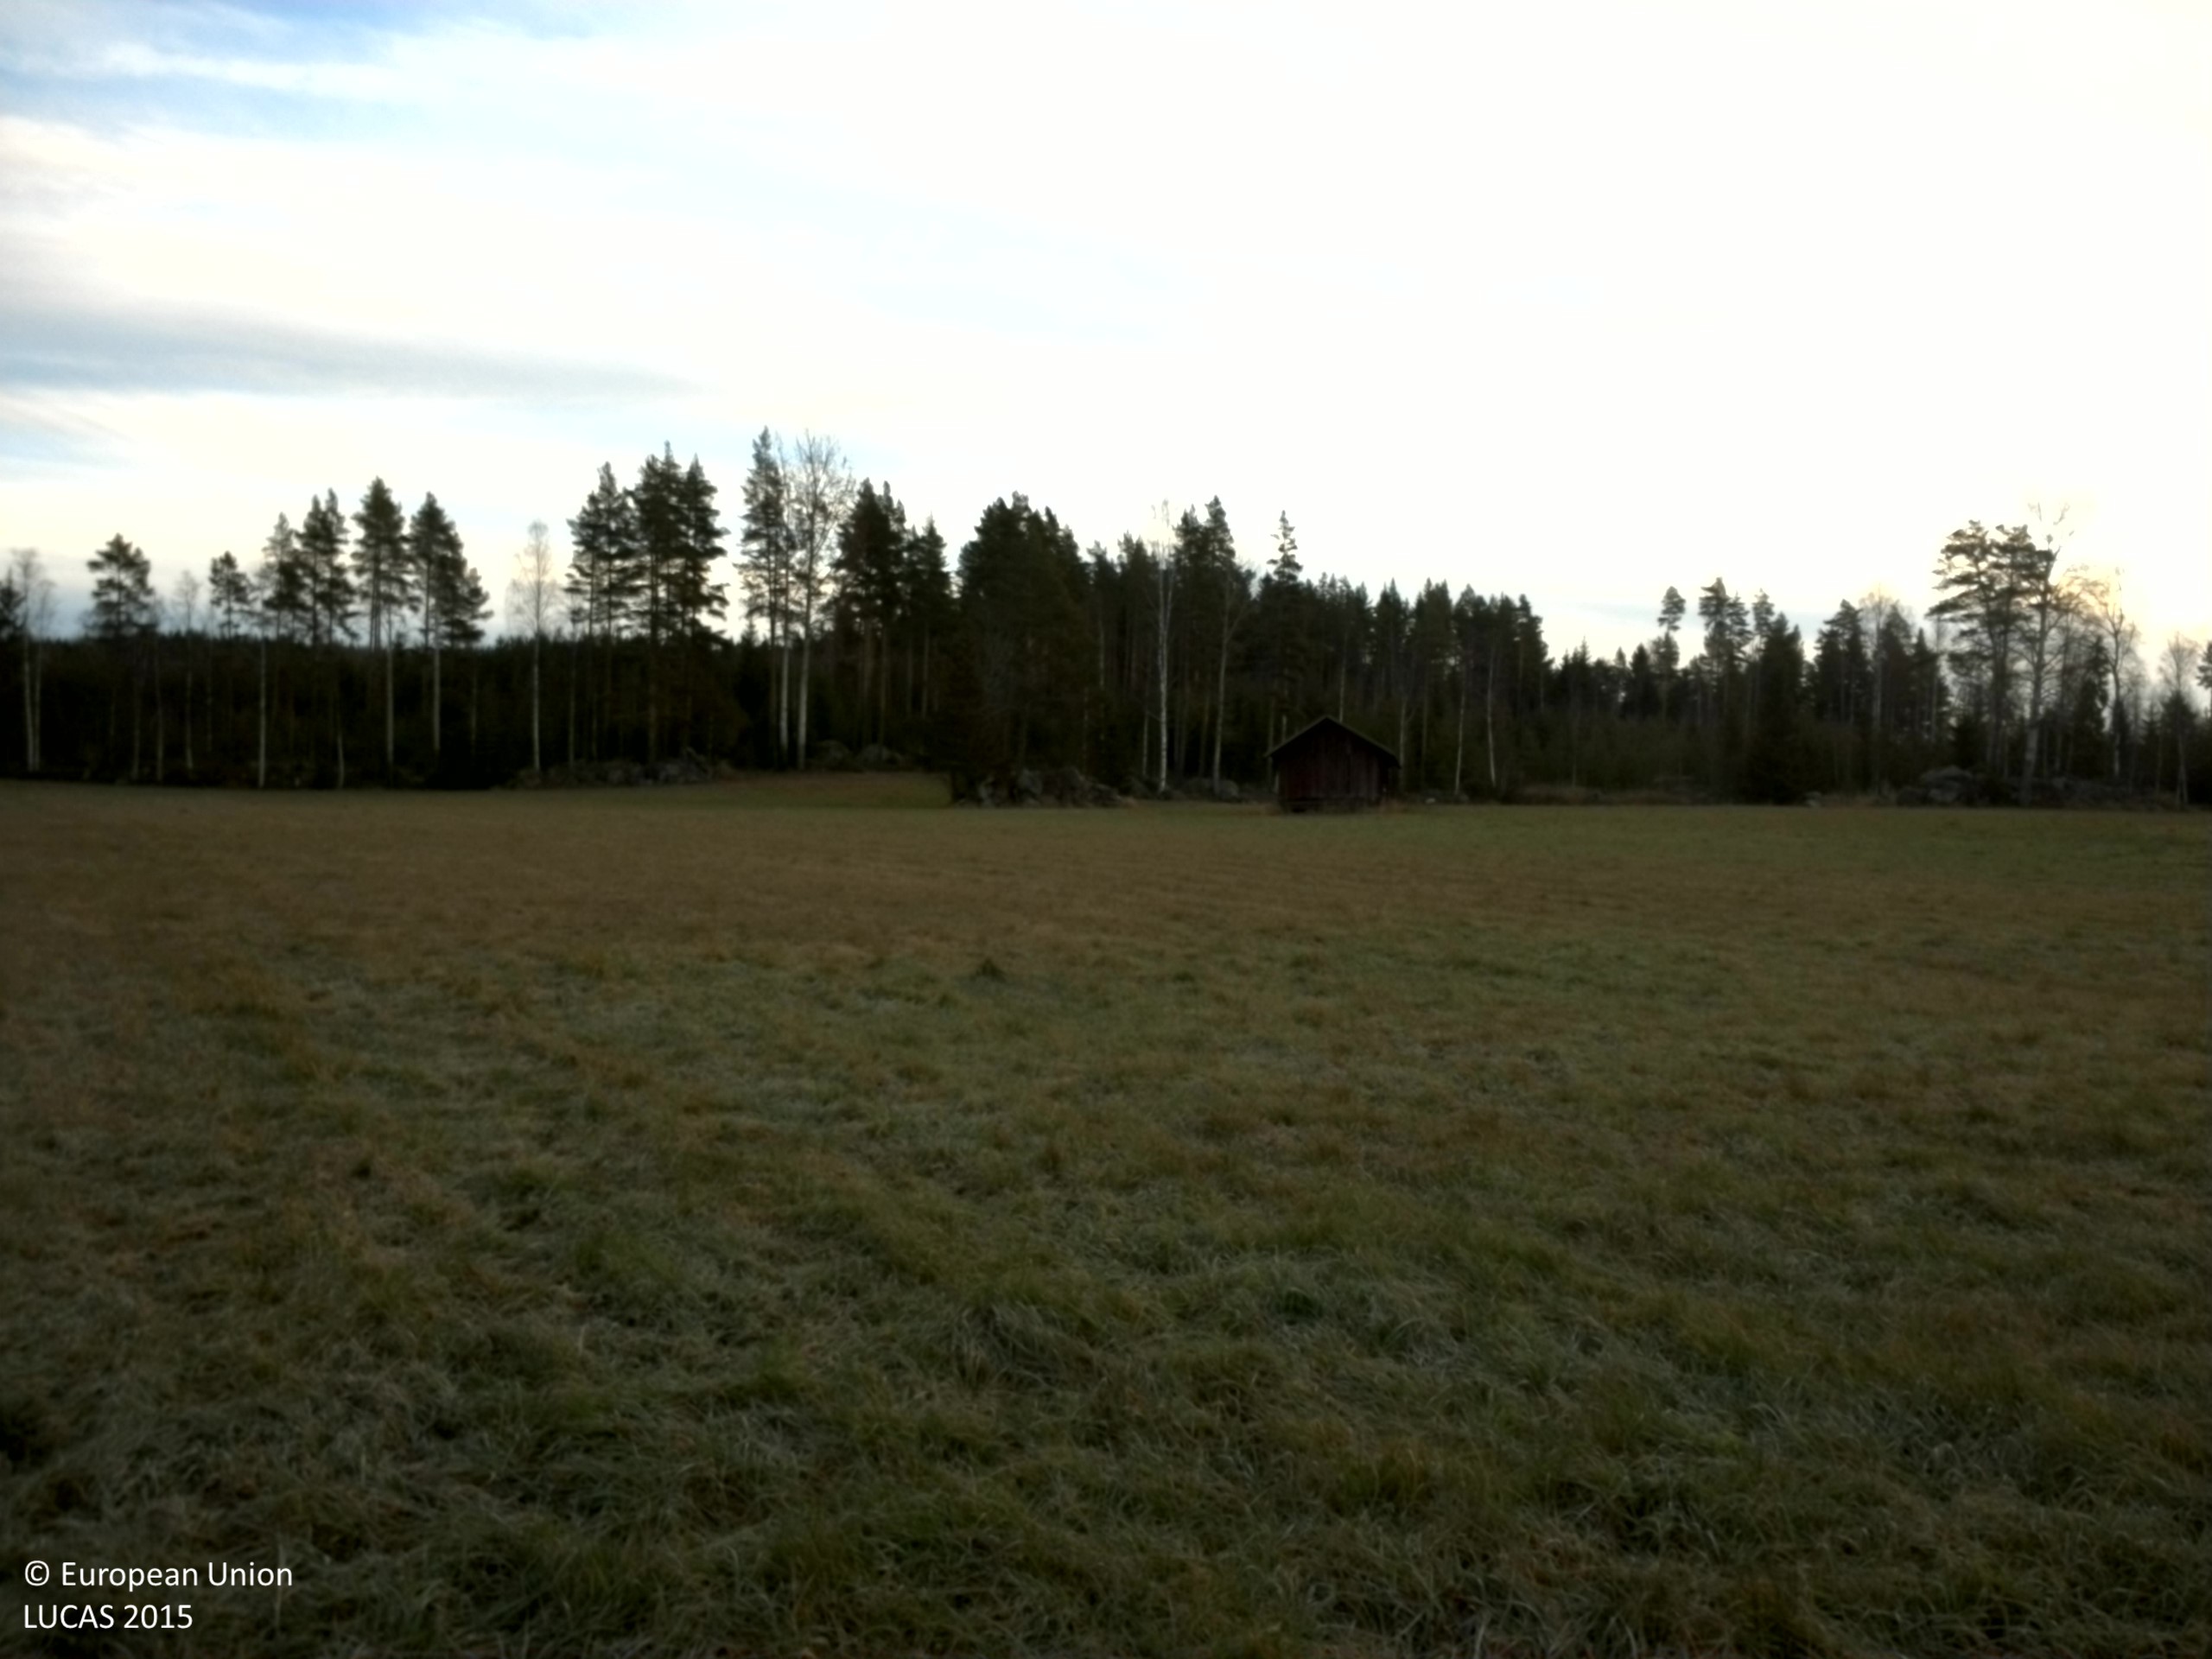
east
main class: Cropland
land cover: Other leguminous and mixtures for fodder
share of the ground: > 75 %
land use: Agriculture (excluding fallow land and kitchen gardens)
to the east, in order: Other leguminous and mixtures for fodder; Pine dominated mixed woodland; Spruce dominated coniferous woodland; Pine dominated mixed woodland; Other mixed woodland
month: November
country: SE
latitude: 61.2783
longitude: 16.4954
